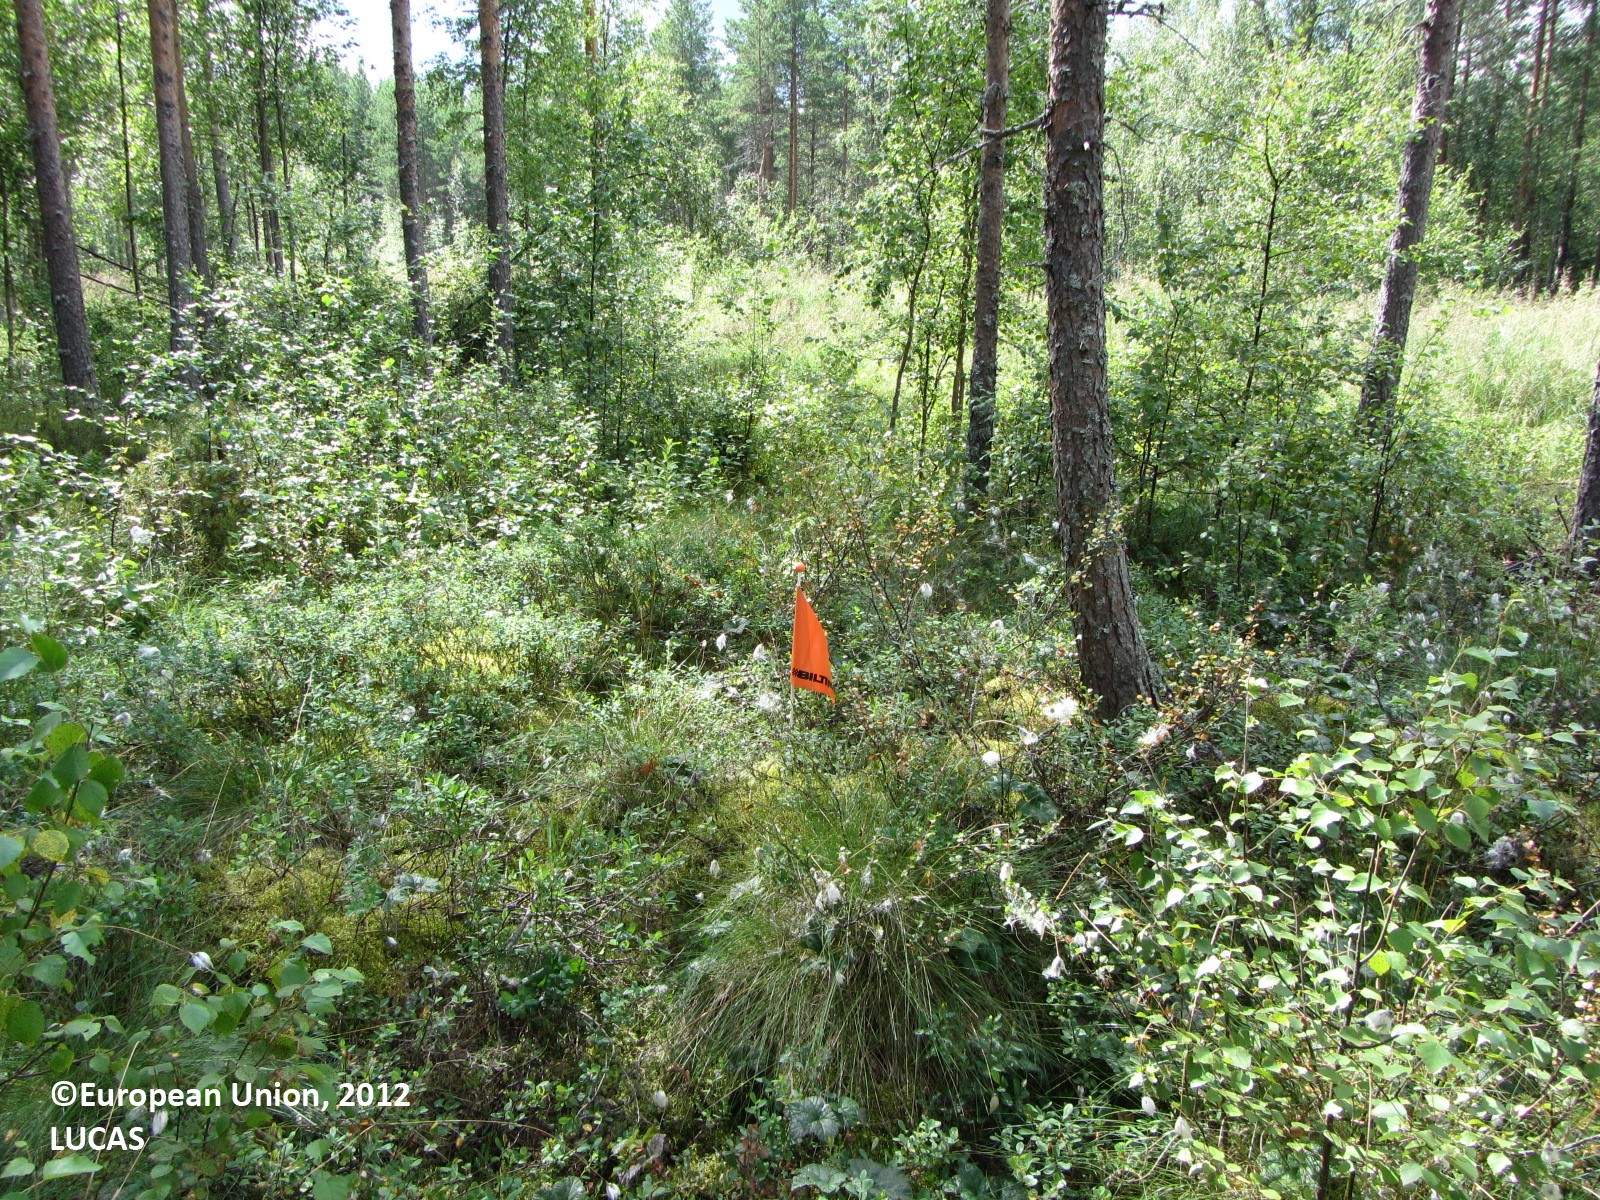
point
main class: Woodland
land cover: Pine dominated mixed woodland
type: boreal forest
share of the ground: 50 - 75 %
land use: Forestry
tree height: > 5 m
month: July
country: FI
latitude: 63.6445
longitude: 24.5968
